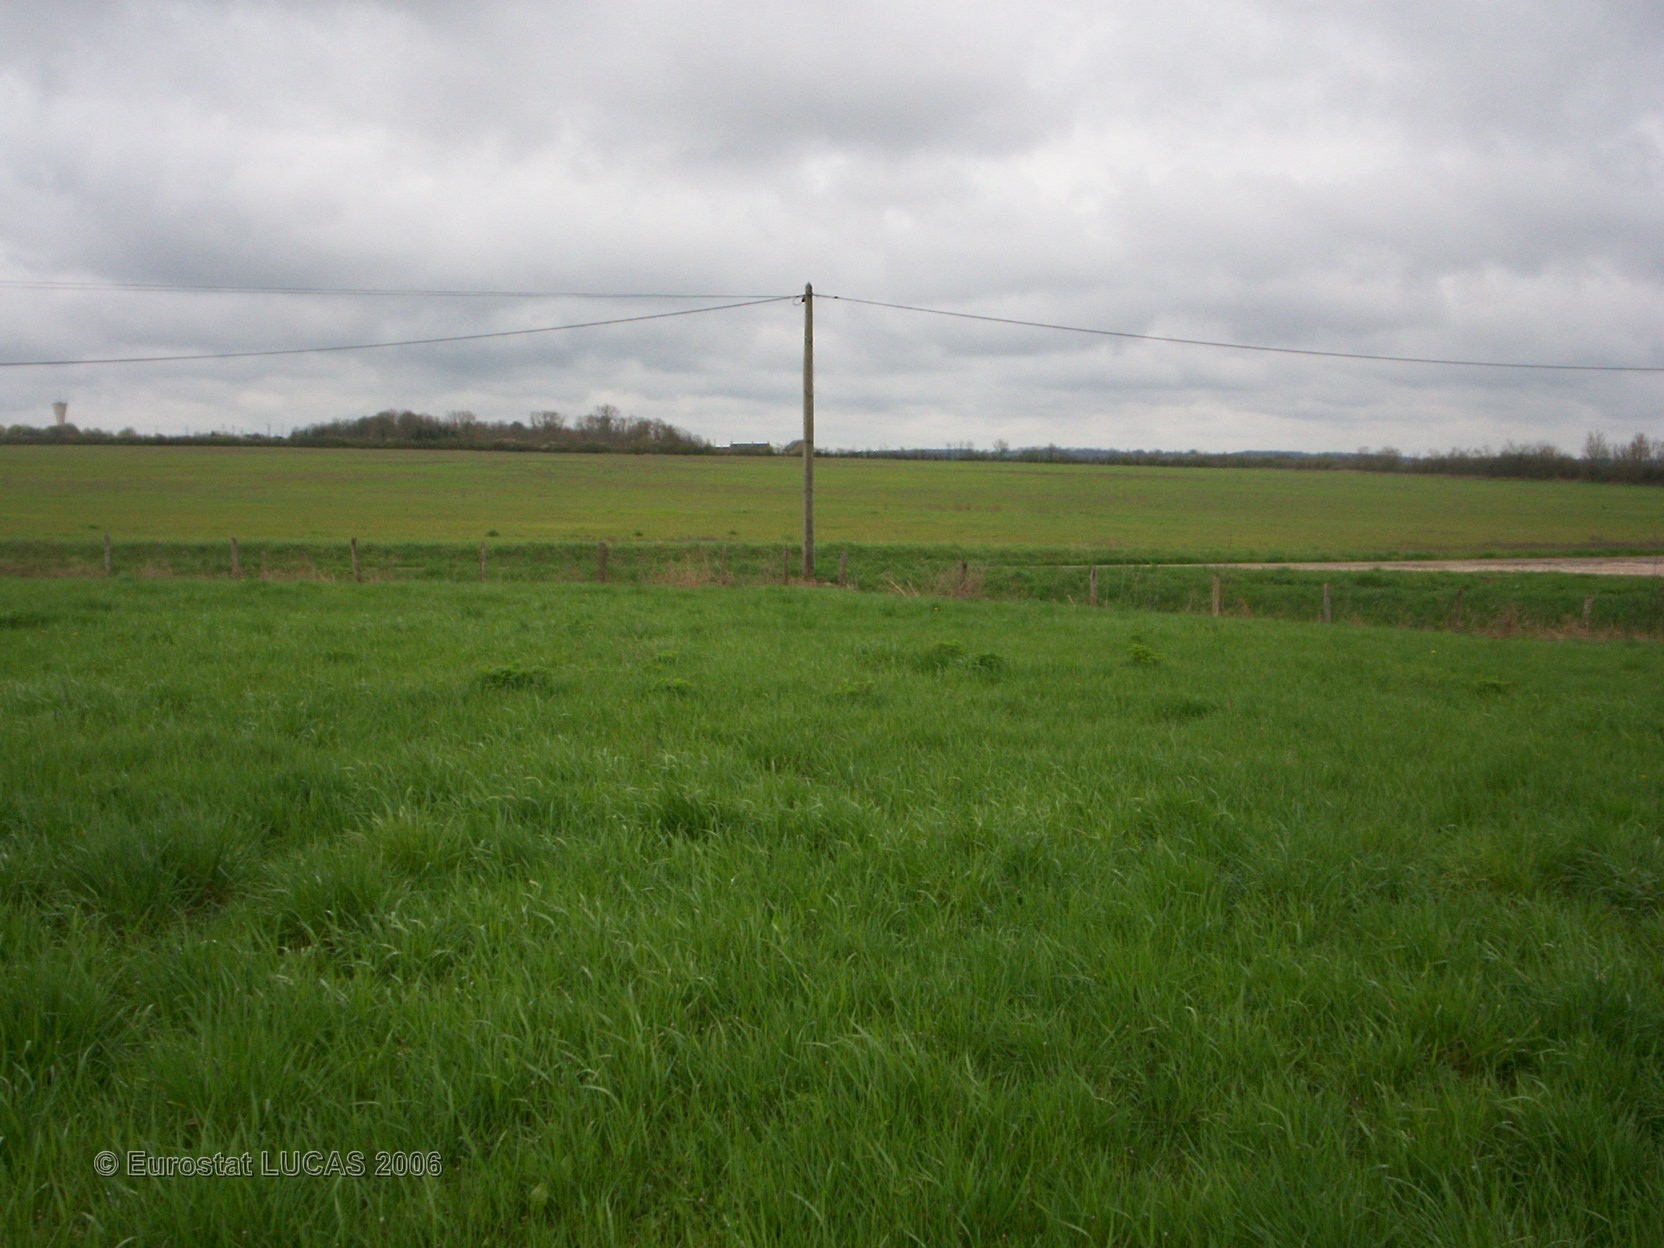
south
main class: Grassland
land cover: Grassland without tree/shrub cover
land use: Agriculture (excluding fallow land and kitchen gardens)
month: April
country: FR
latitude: 46.8160
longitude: 3.1158
